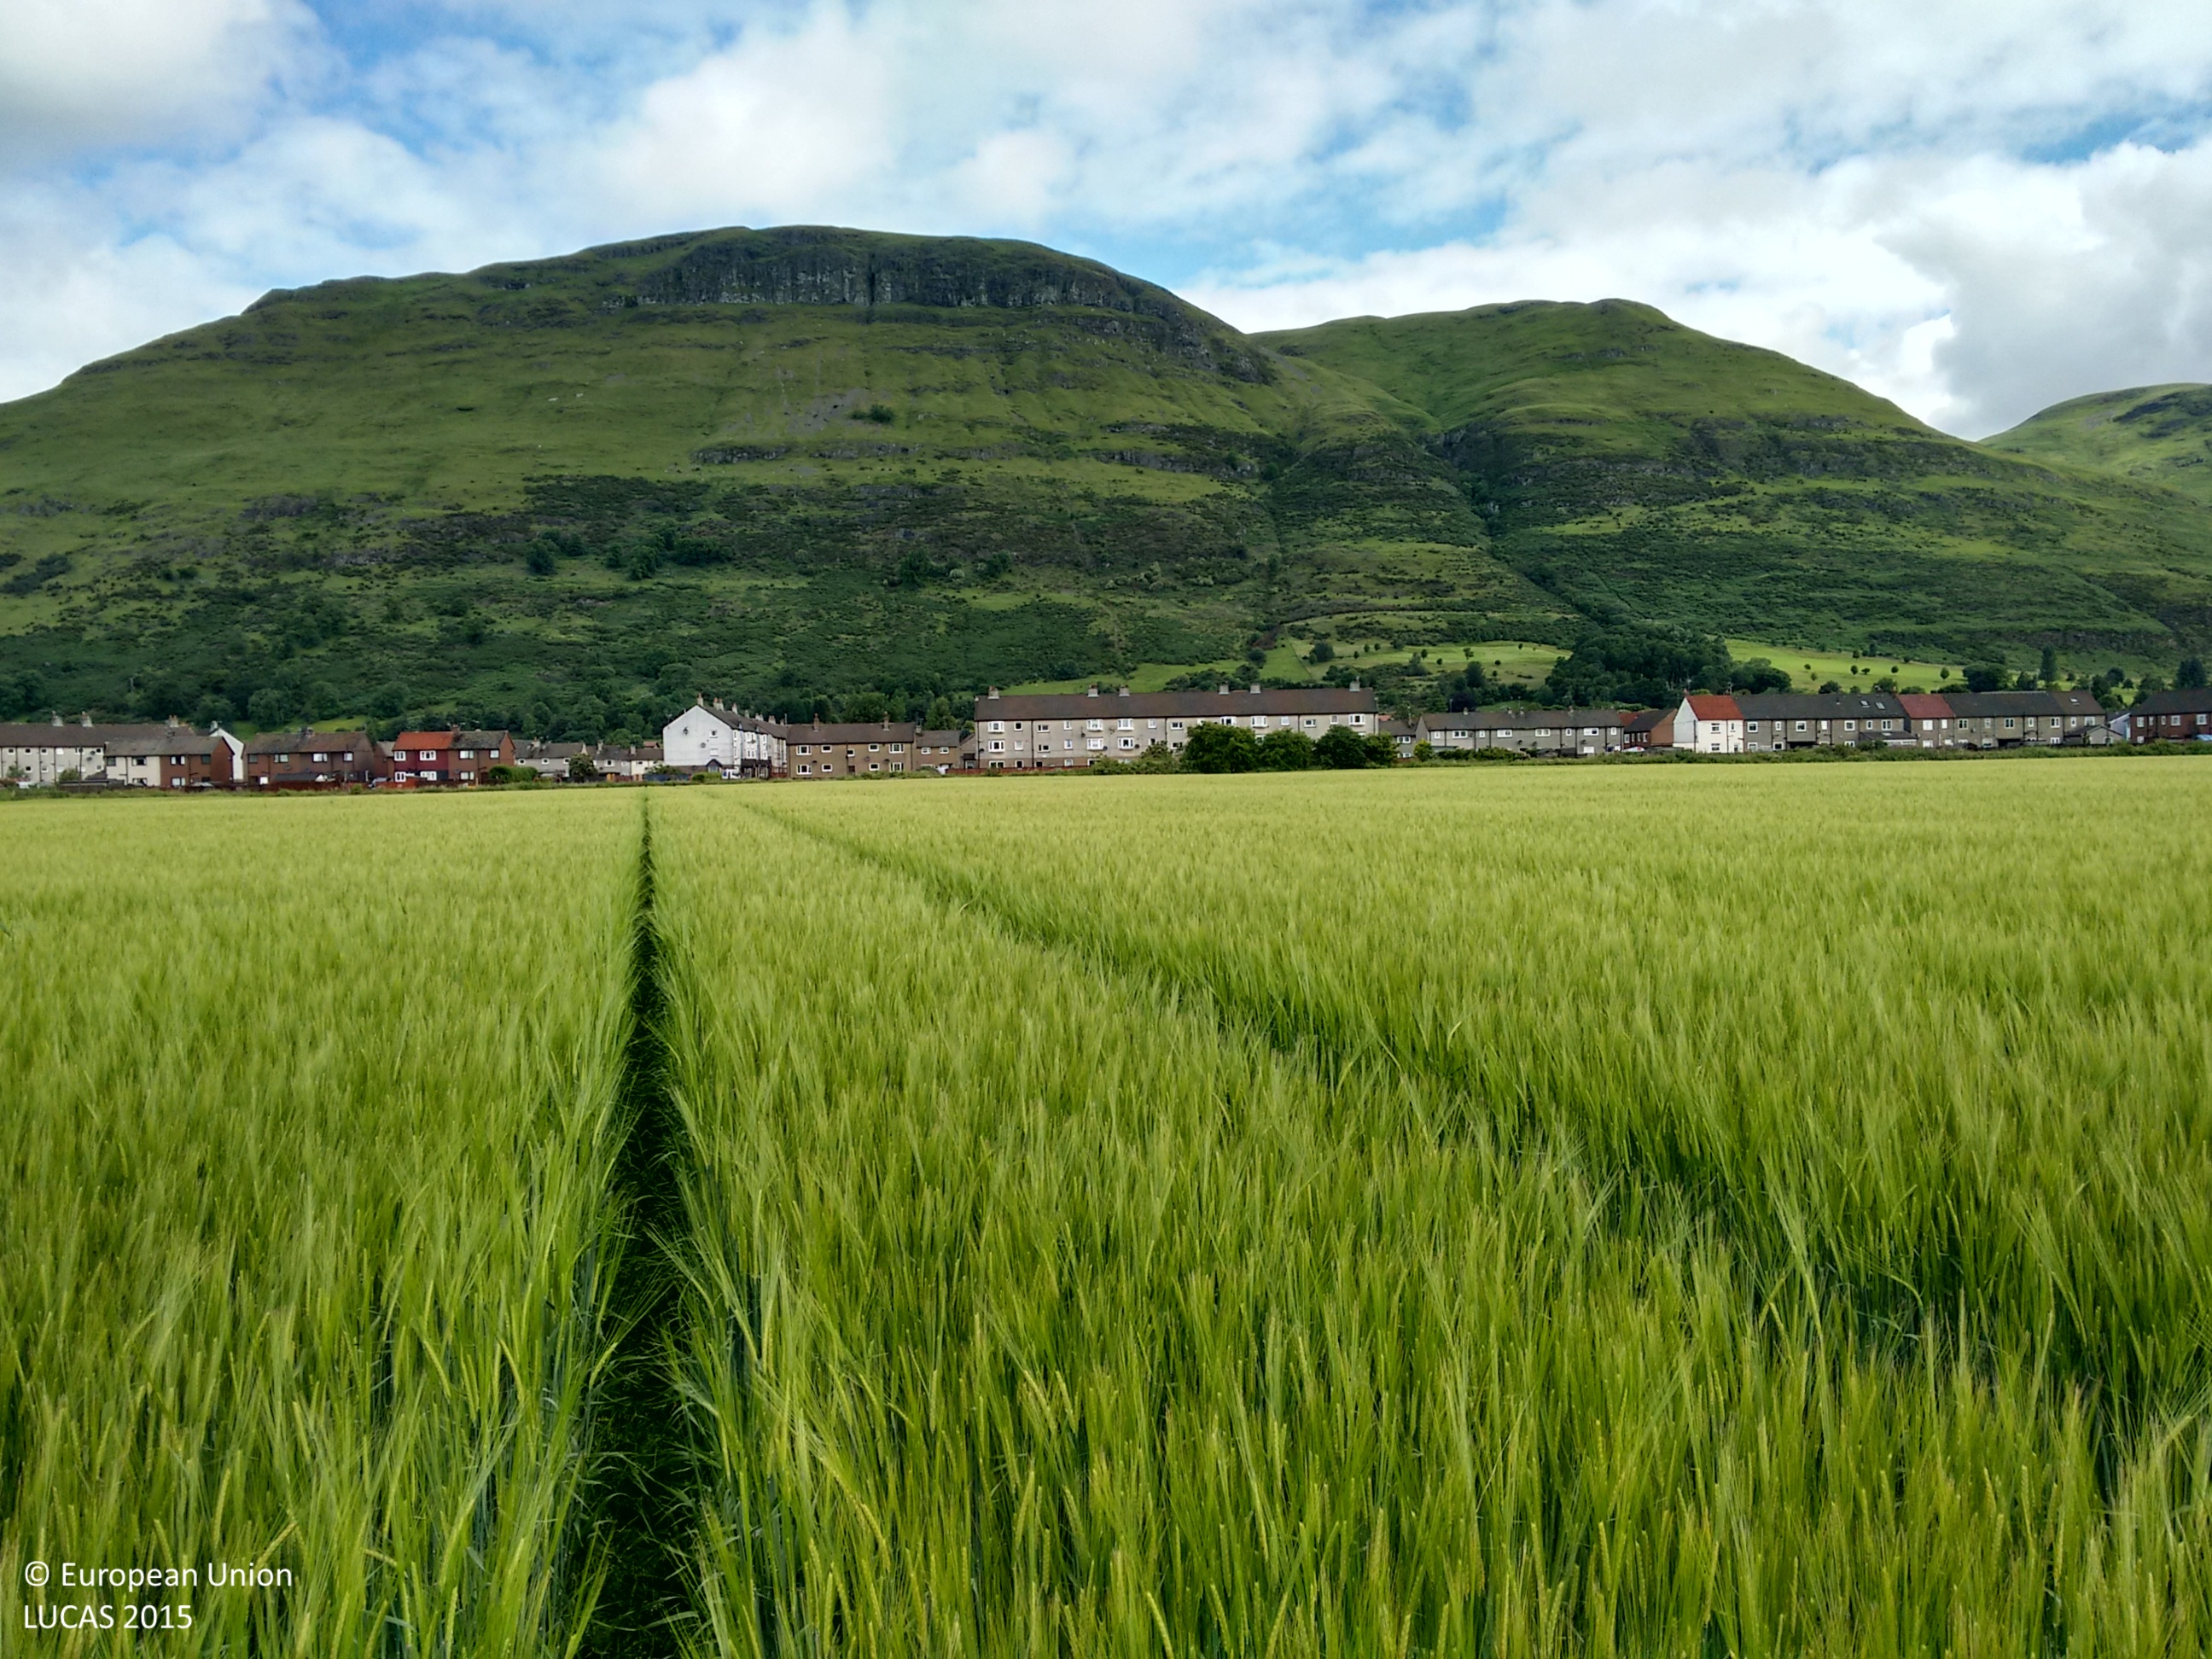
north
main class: Cropland
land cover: Barley
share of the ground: > 75 %
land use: Agriculture (excluding fallow land and kitchen gardens)
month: July
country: GB
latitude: 56.1485
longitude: -3.8132
